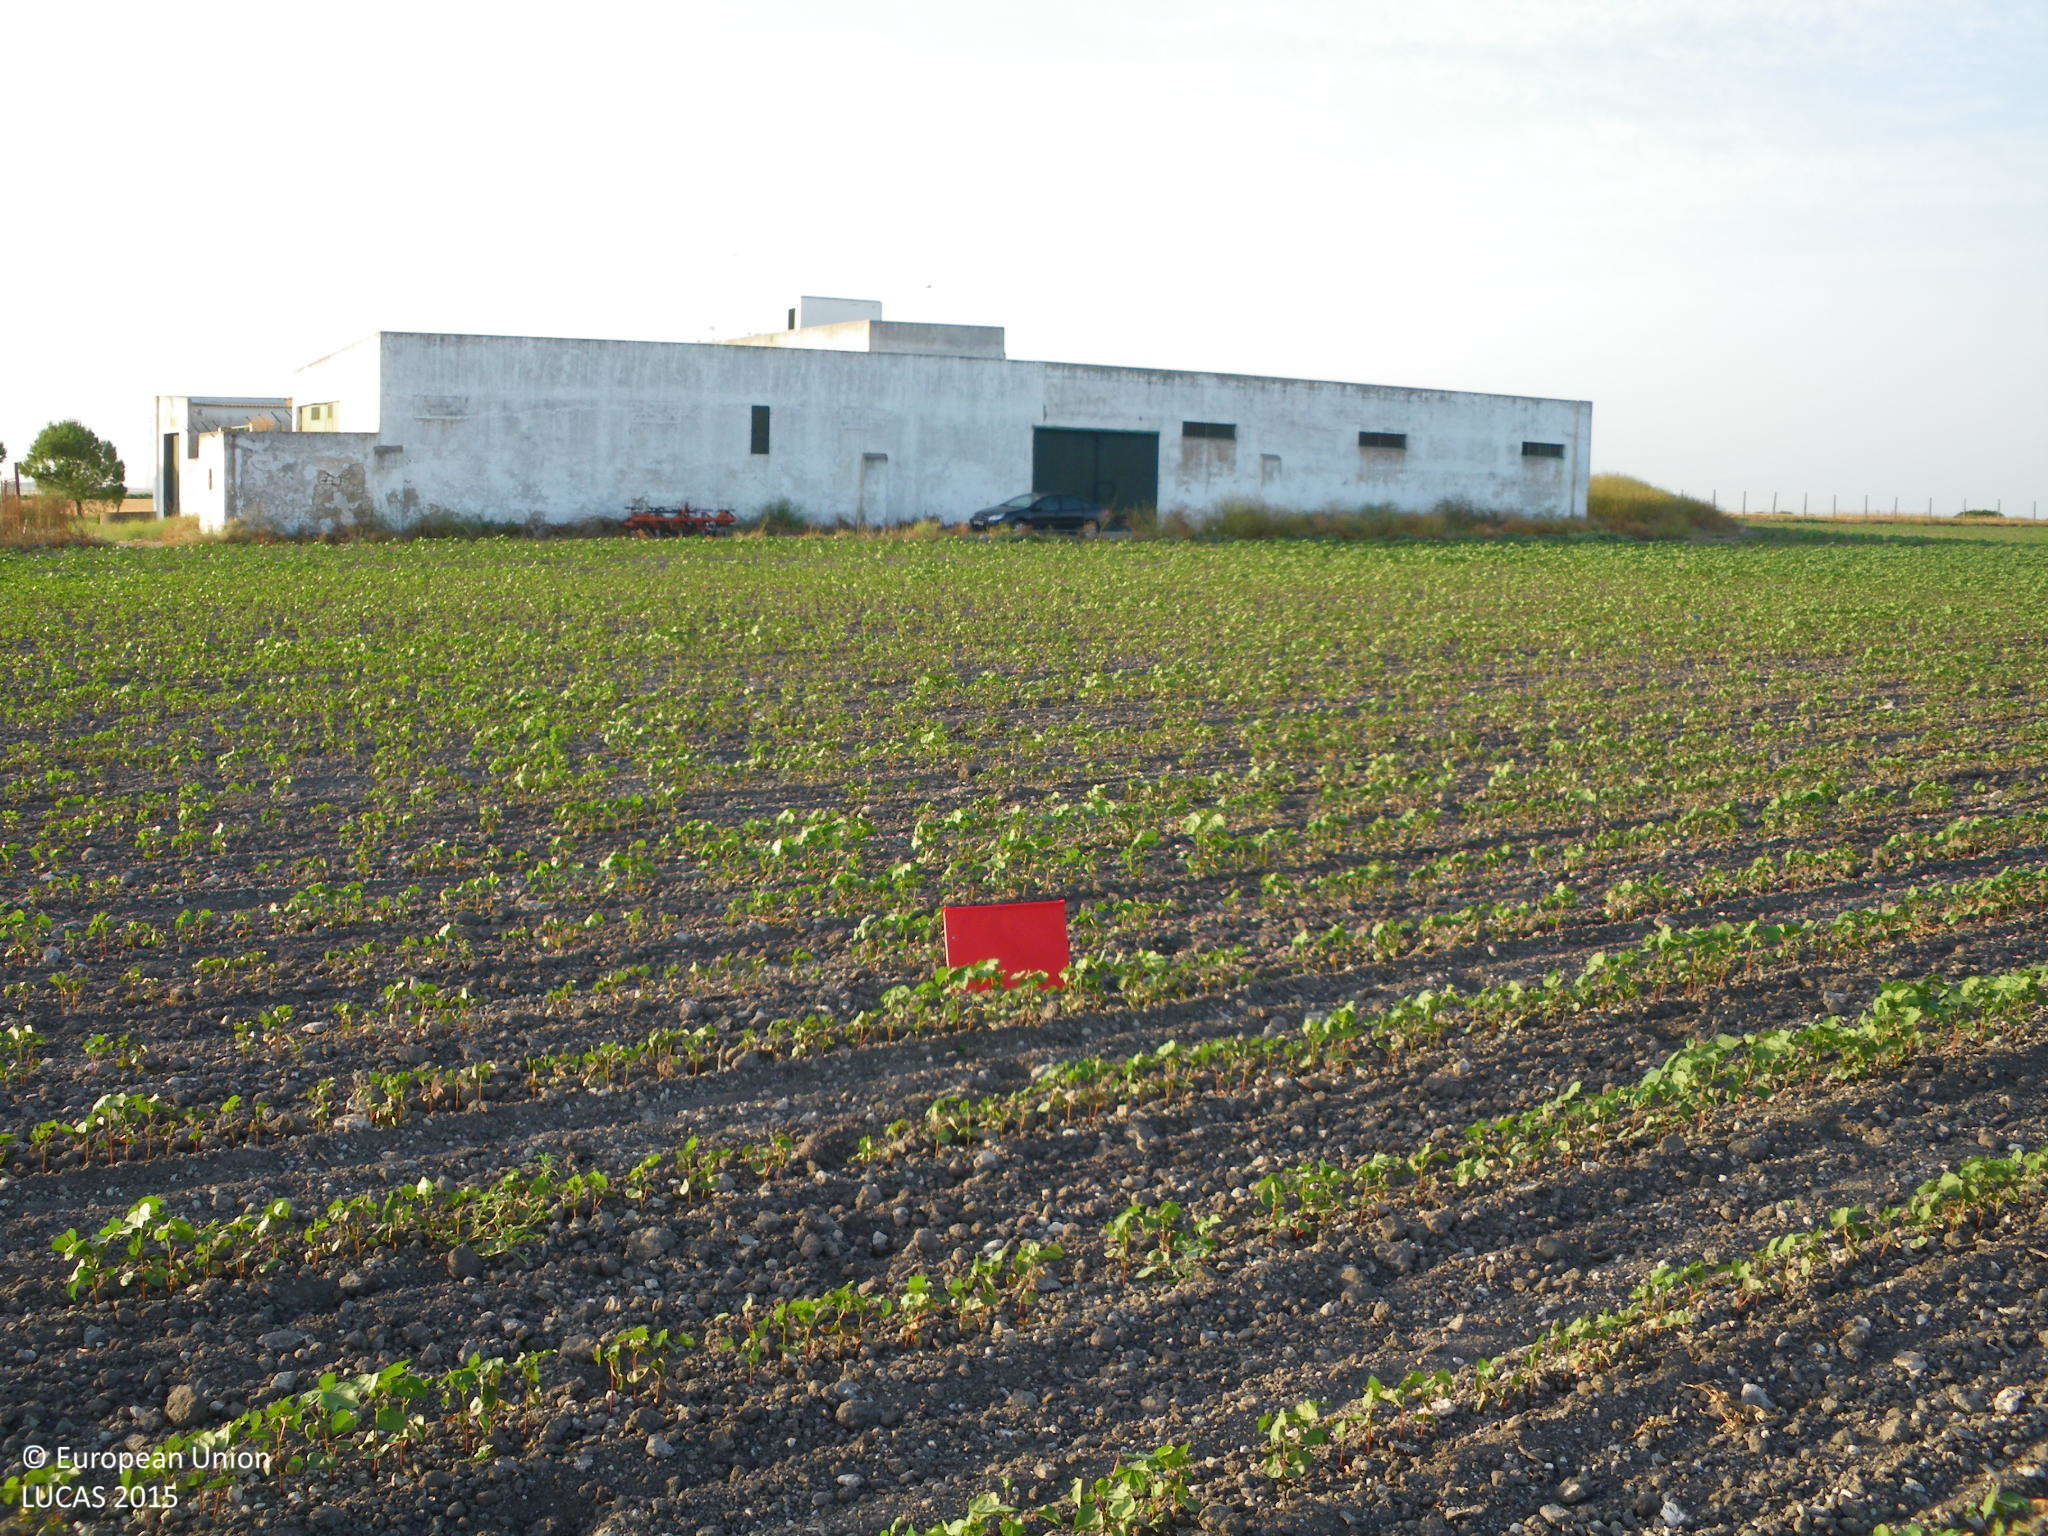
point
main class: Cropland
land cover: Cotton
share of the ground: 10 - 25 %
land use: Agriculture (excluding fallow land and kitchen gardens)
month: June
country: ES
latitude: 36.6682
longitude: -6.2711
